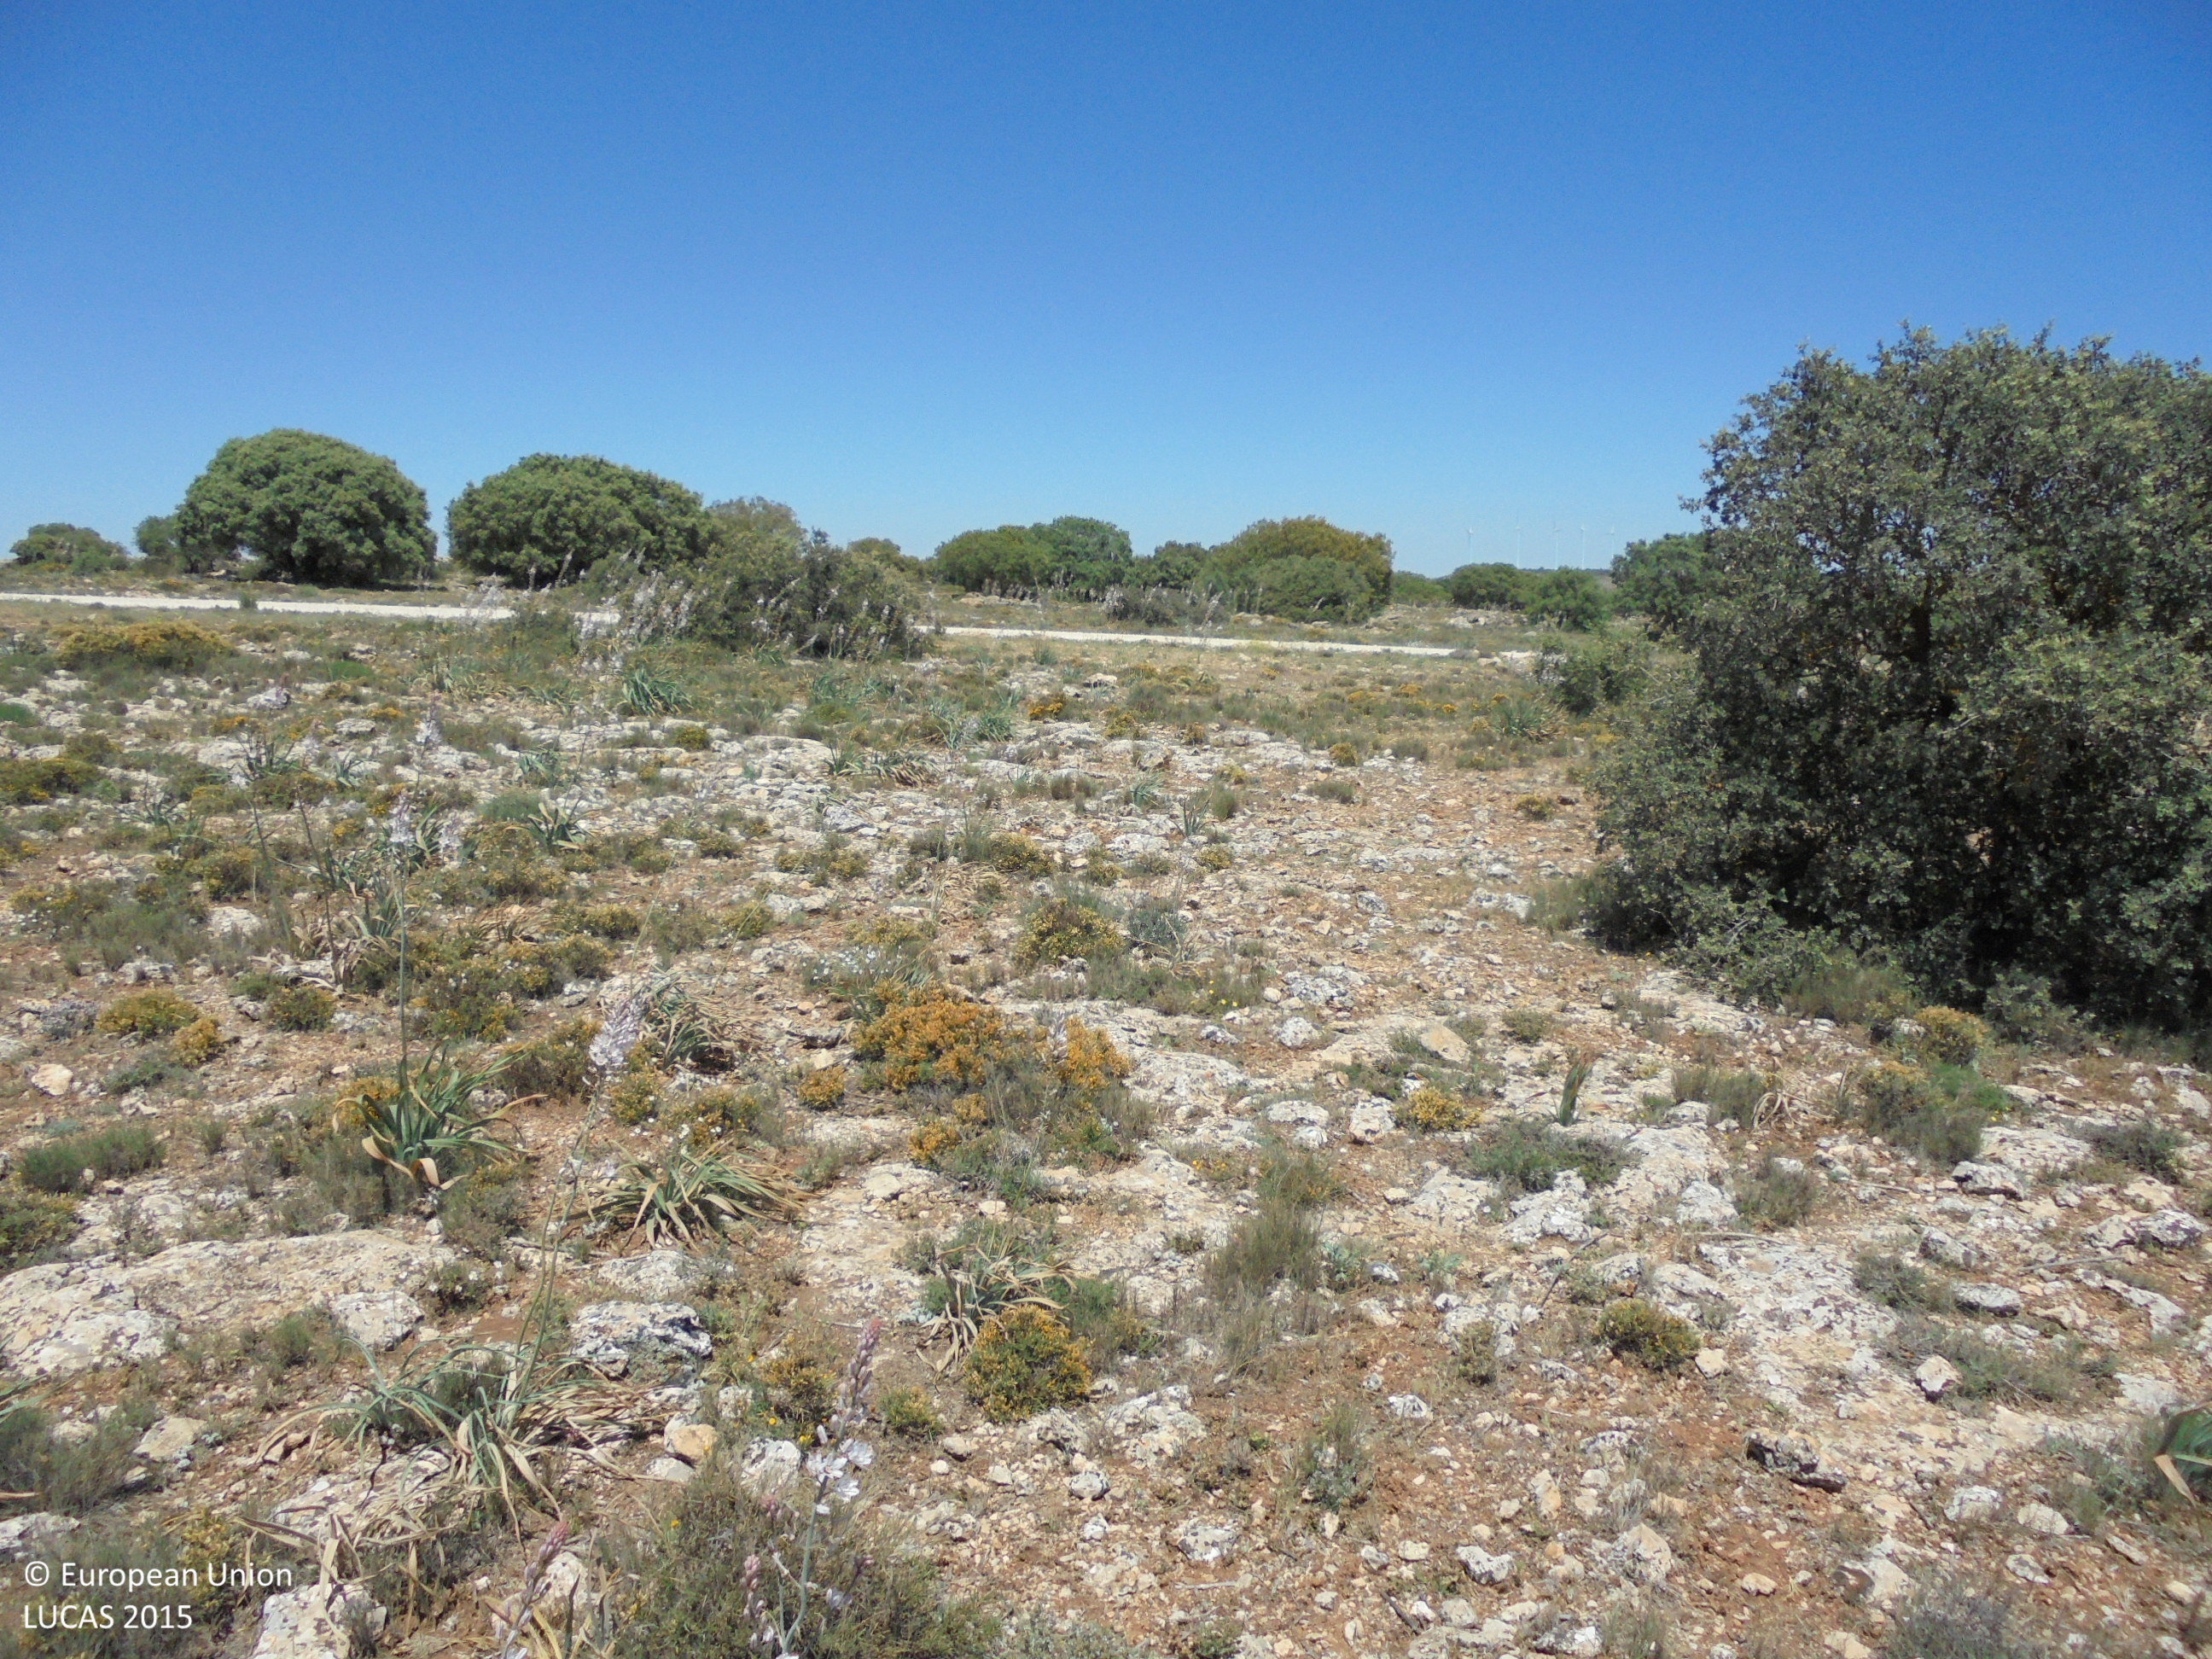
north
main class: Shrubland
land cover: Shrubland without tree cover
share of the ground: 50 - 75 %
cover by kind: shrubs 70 %, consolidated bare surface 20 %, unconsolidated bare surface 10 %
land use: Agriculture (excluding fallow land and kitchen gardens)
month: May
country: ES
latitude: 38.9905
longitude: -1.4621
